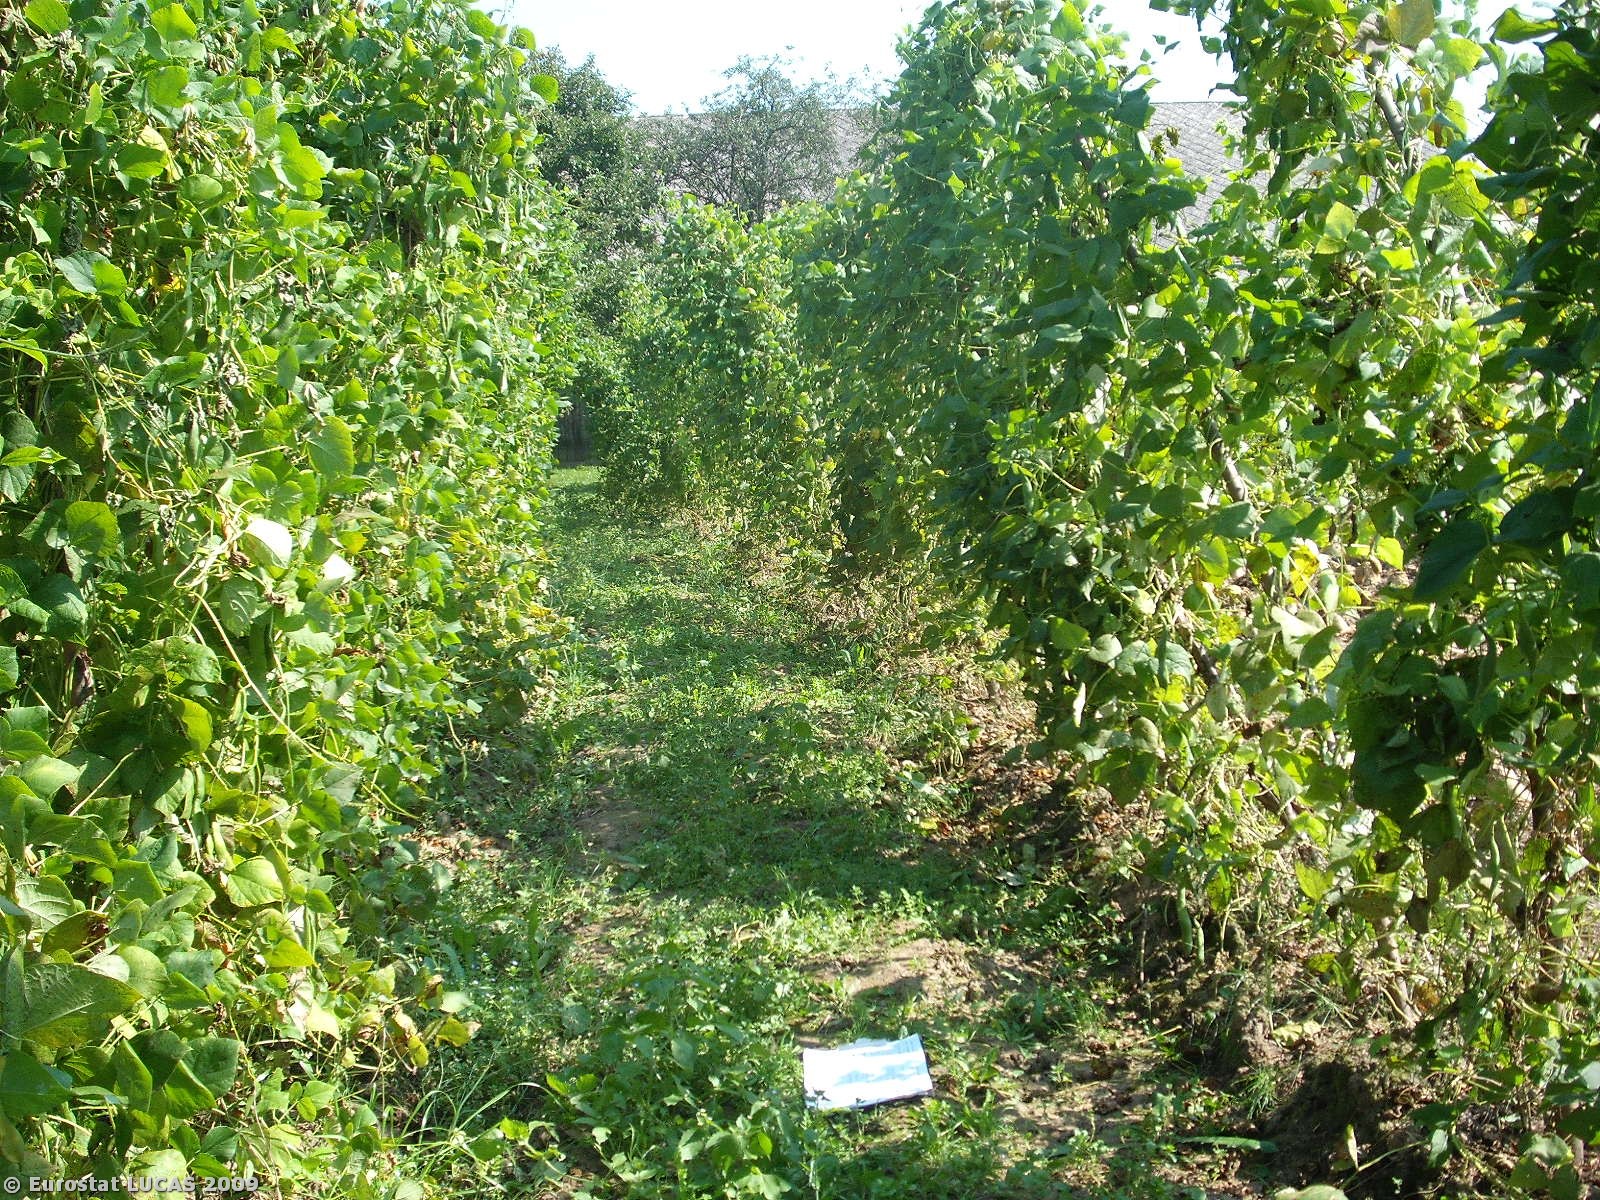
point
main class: Cropland
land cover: Dry pulses
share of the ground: 25 - 50 %
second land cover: Spontaneously vegetated surfaces
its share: 50 - 75 %
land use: Agriculture (excluding fallow land and kitchen gardens)
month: September
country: PL
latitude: 49.7483
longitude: 20.5438
